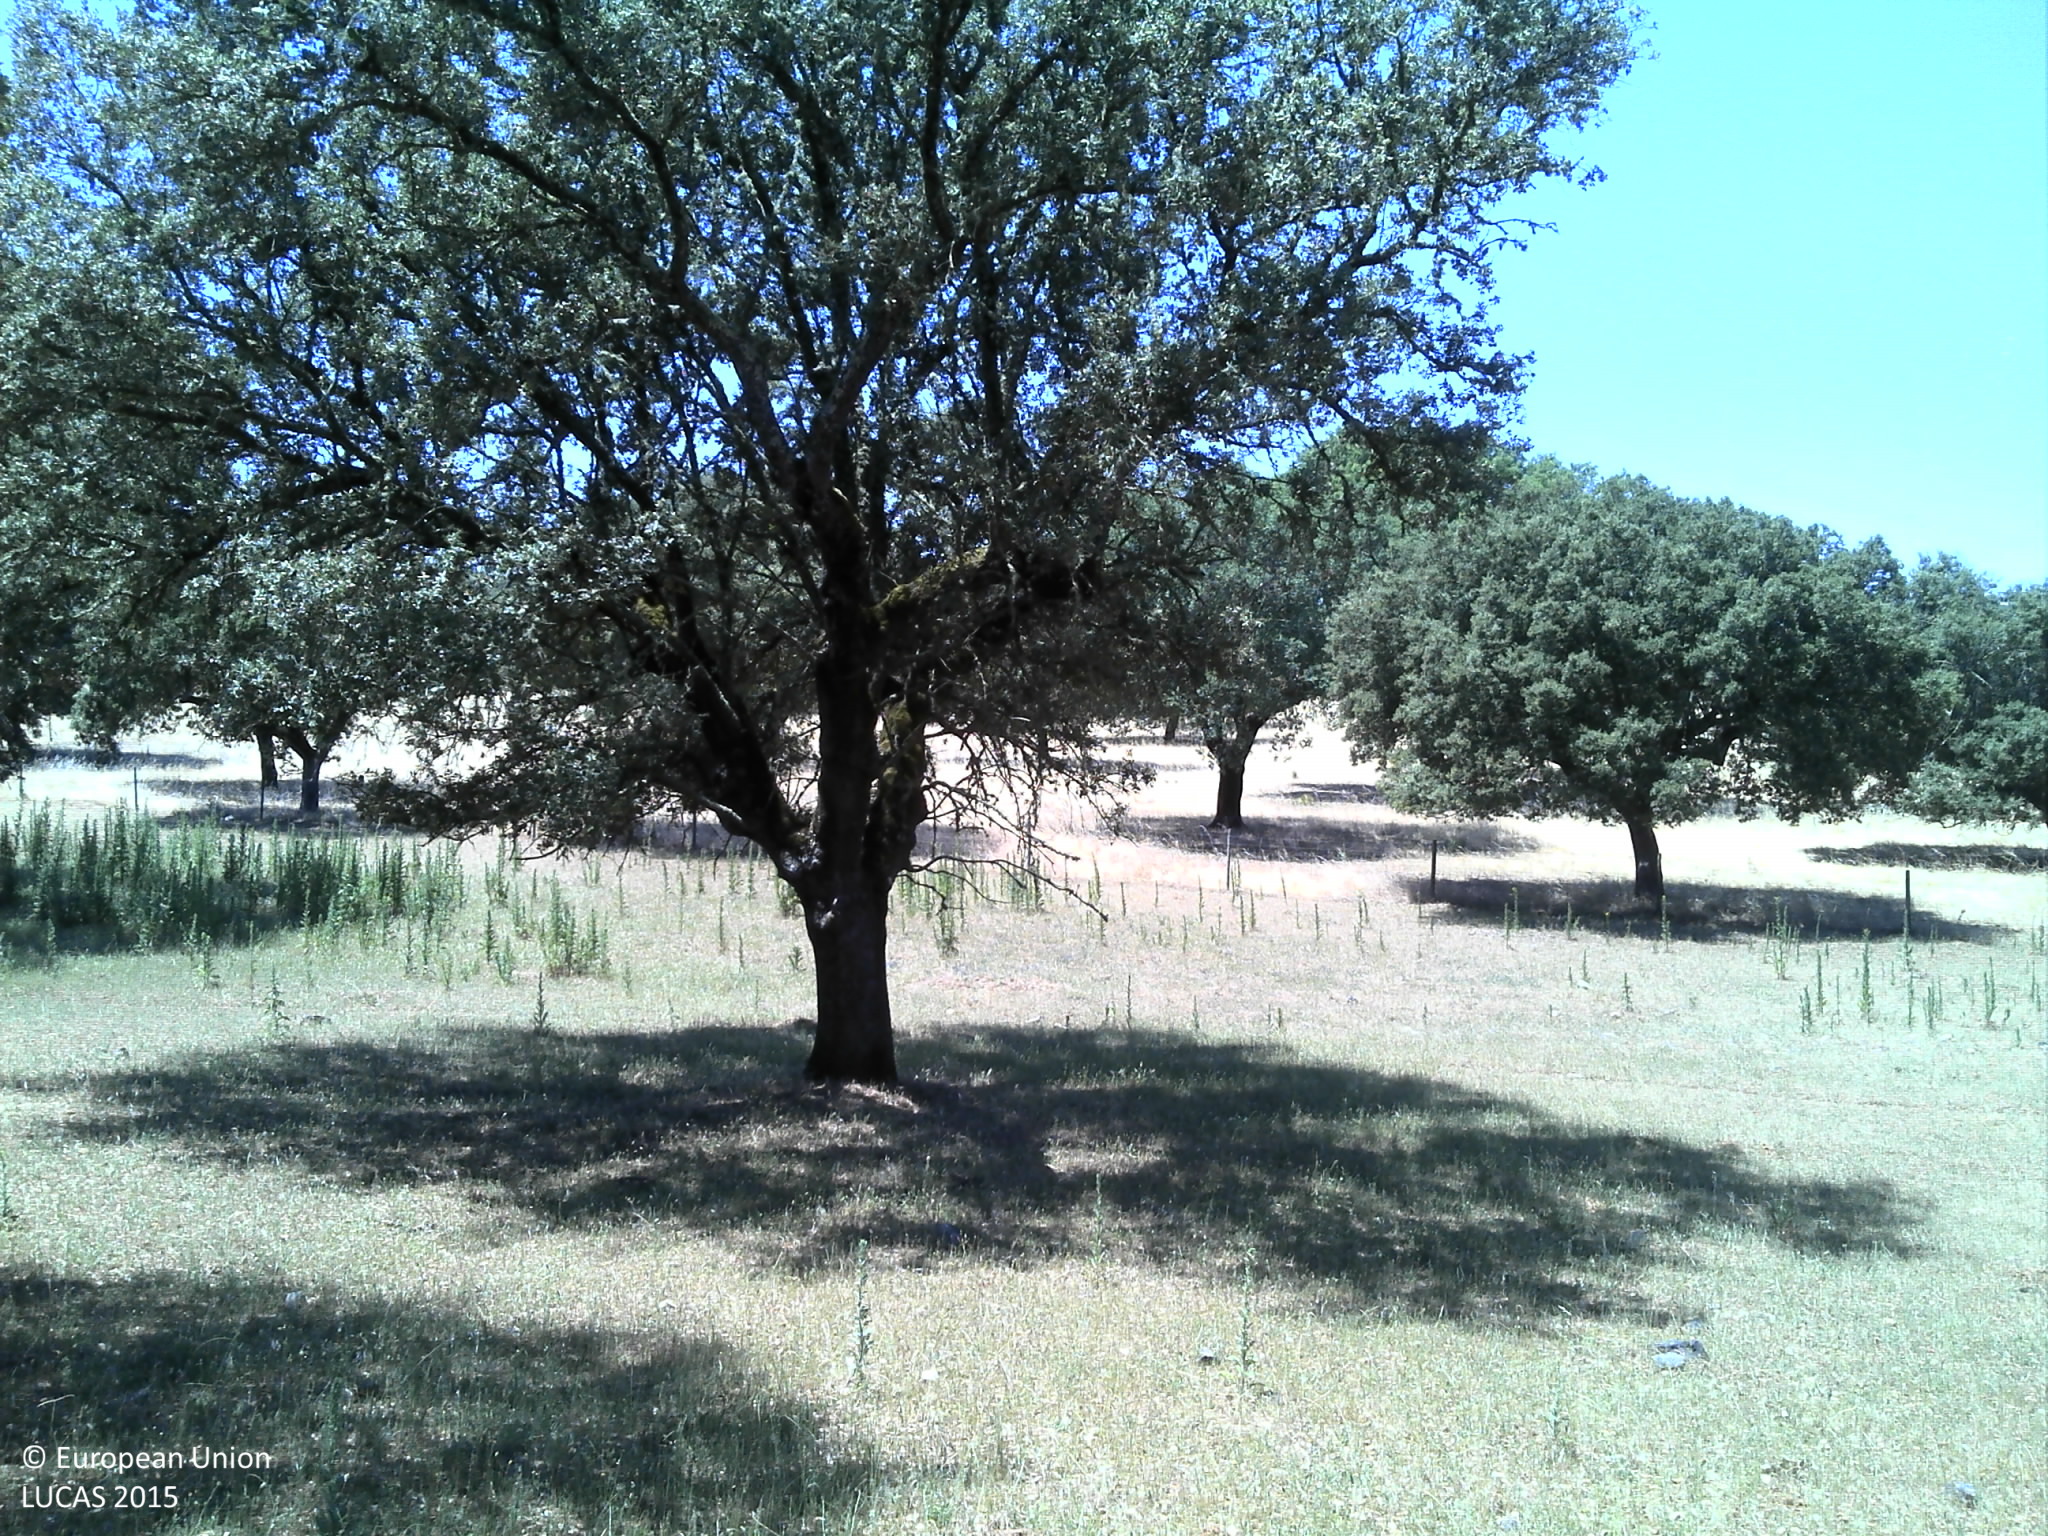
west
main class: Woodland
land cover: Broadleaved woodland
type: broadleaved evergreen forest
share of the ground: 25 - 50 %
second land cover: Grassland without tree/shrub cover
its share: 25 - 50 %
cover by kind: broadleaved forest trees 40 %, unconsolidated bare surface 35 %, herbaceous plants 25 %
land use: Forestry
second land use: Agriculture (excluding fallow land and kitchen gardens)
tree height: > 5 m
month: May
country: PT
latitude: 38.9550
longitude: -7.6141
